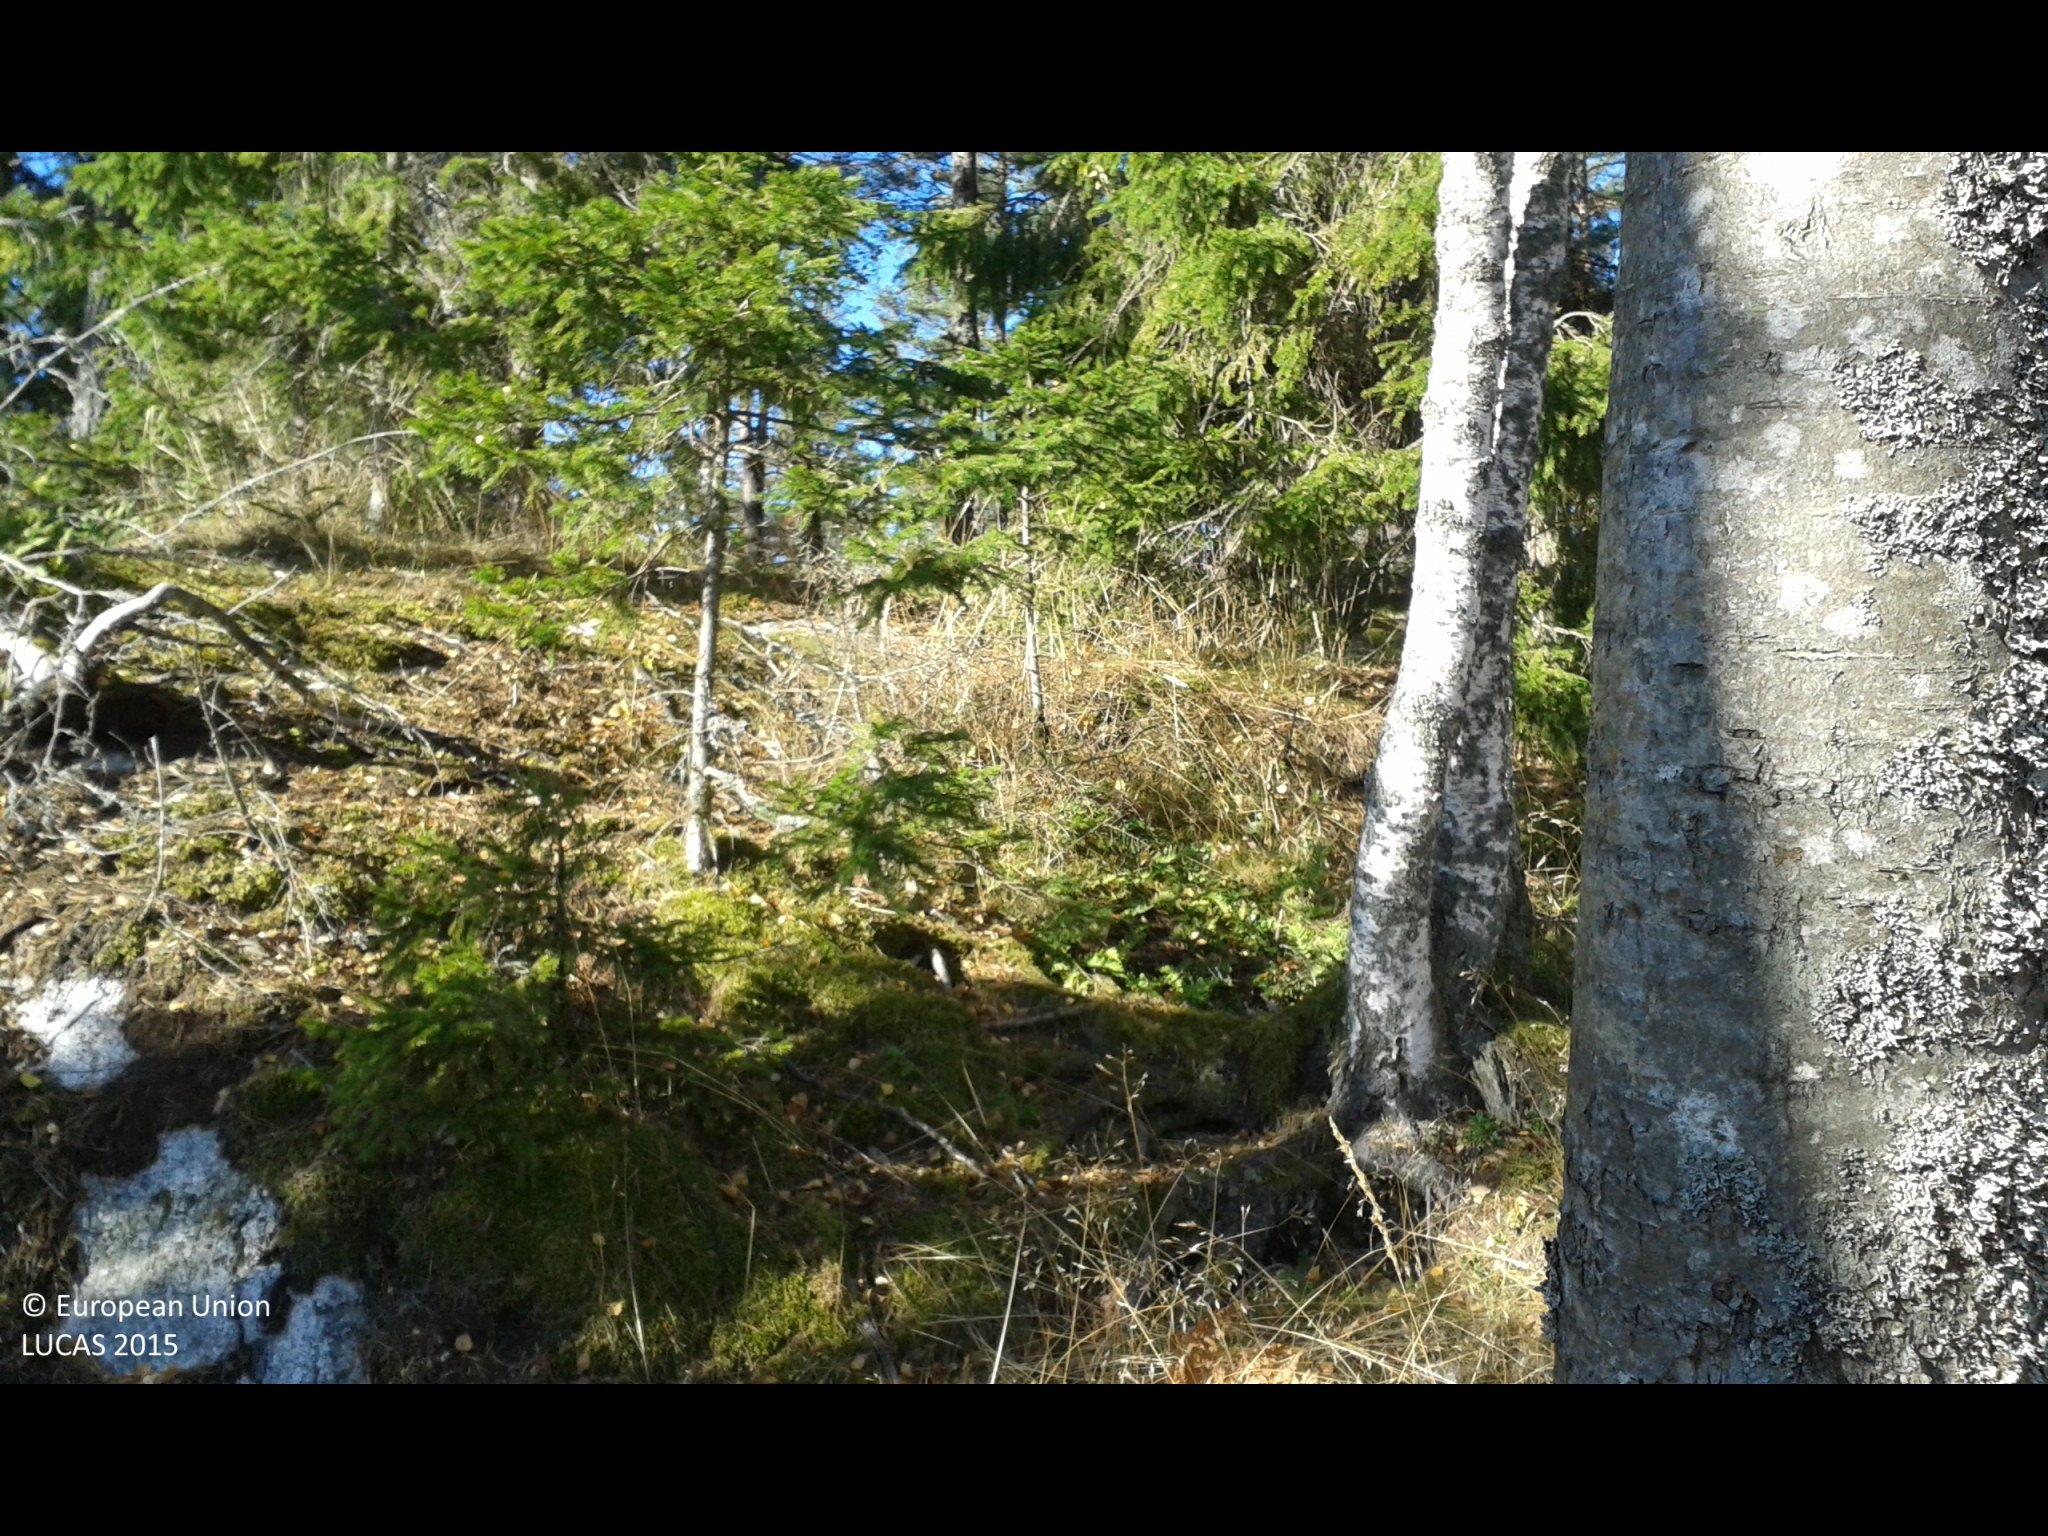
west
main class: Woodland
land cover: Spruce dominated mixed woodland
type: boreal forest
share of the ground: 25 - 50 %
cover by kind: herbaceous plants 55 %, coniferous forest trees 25 %, broadleaved forest trees 20 %
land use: Forestry
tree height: > 5 m
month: October
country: SE
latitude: 58.8329
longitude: 17.3254
